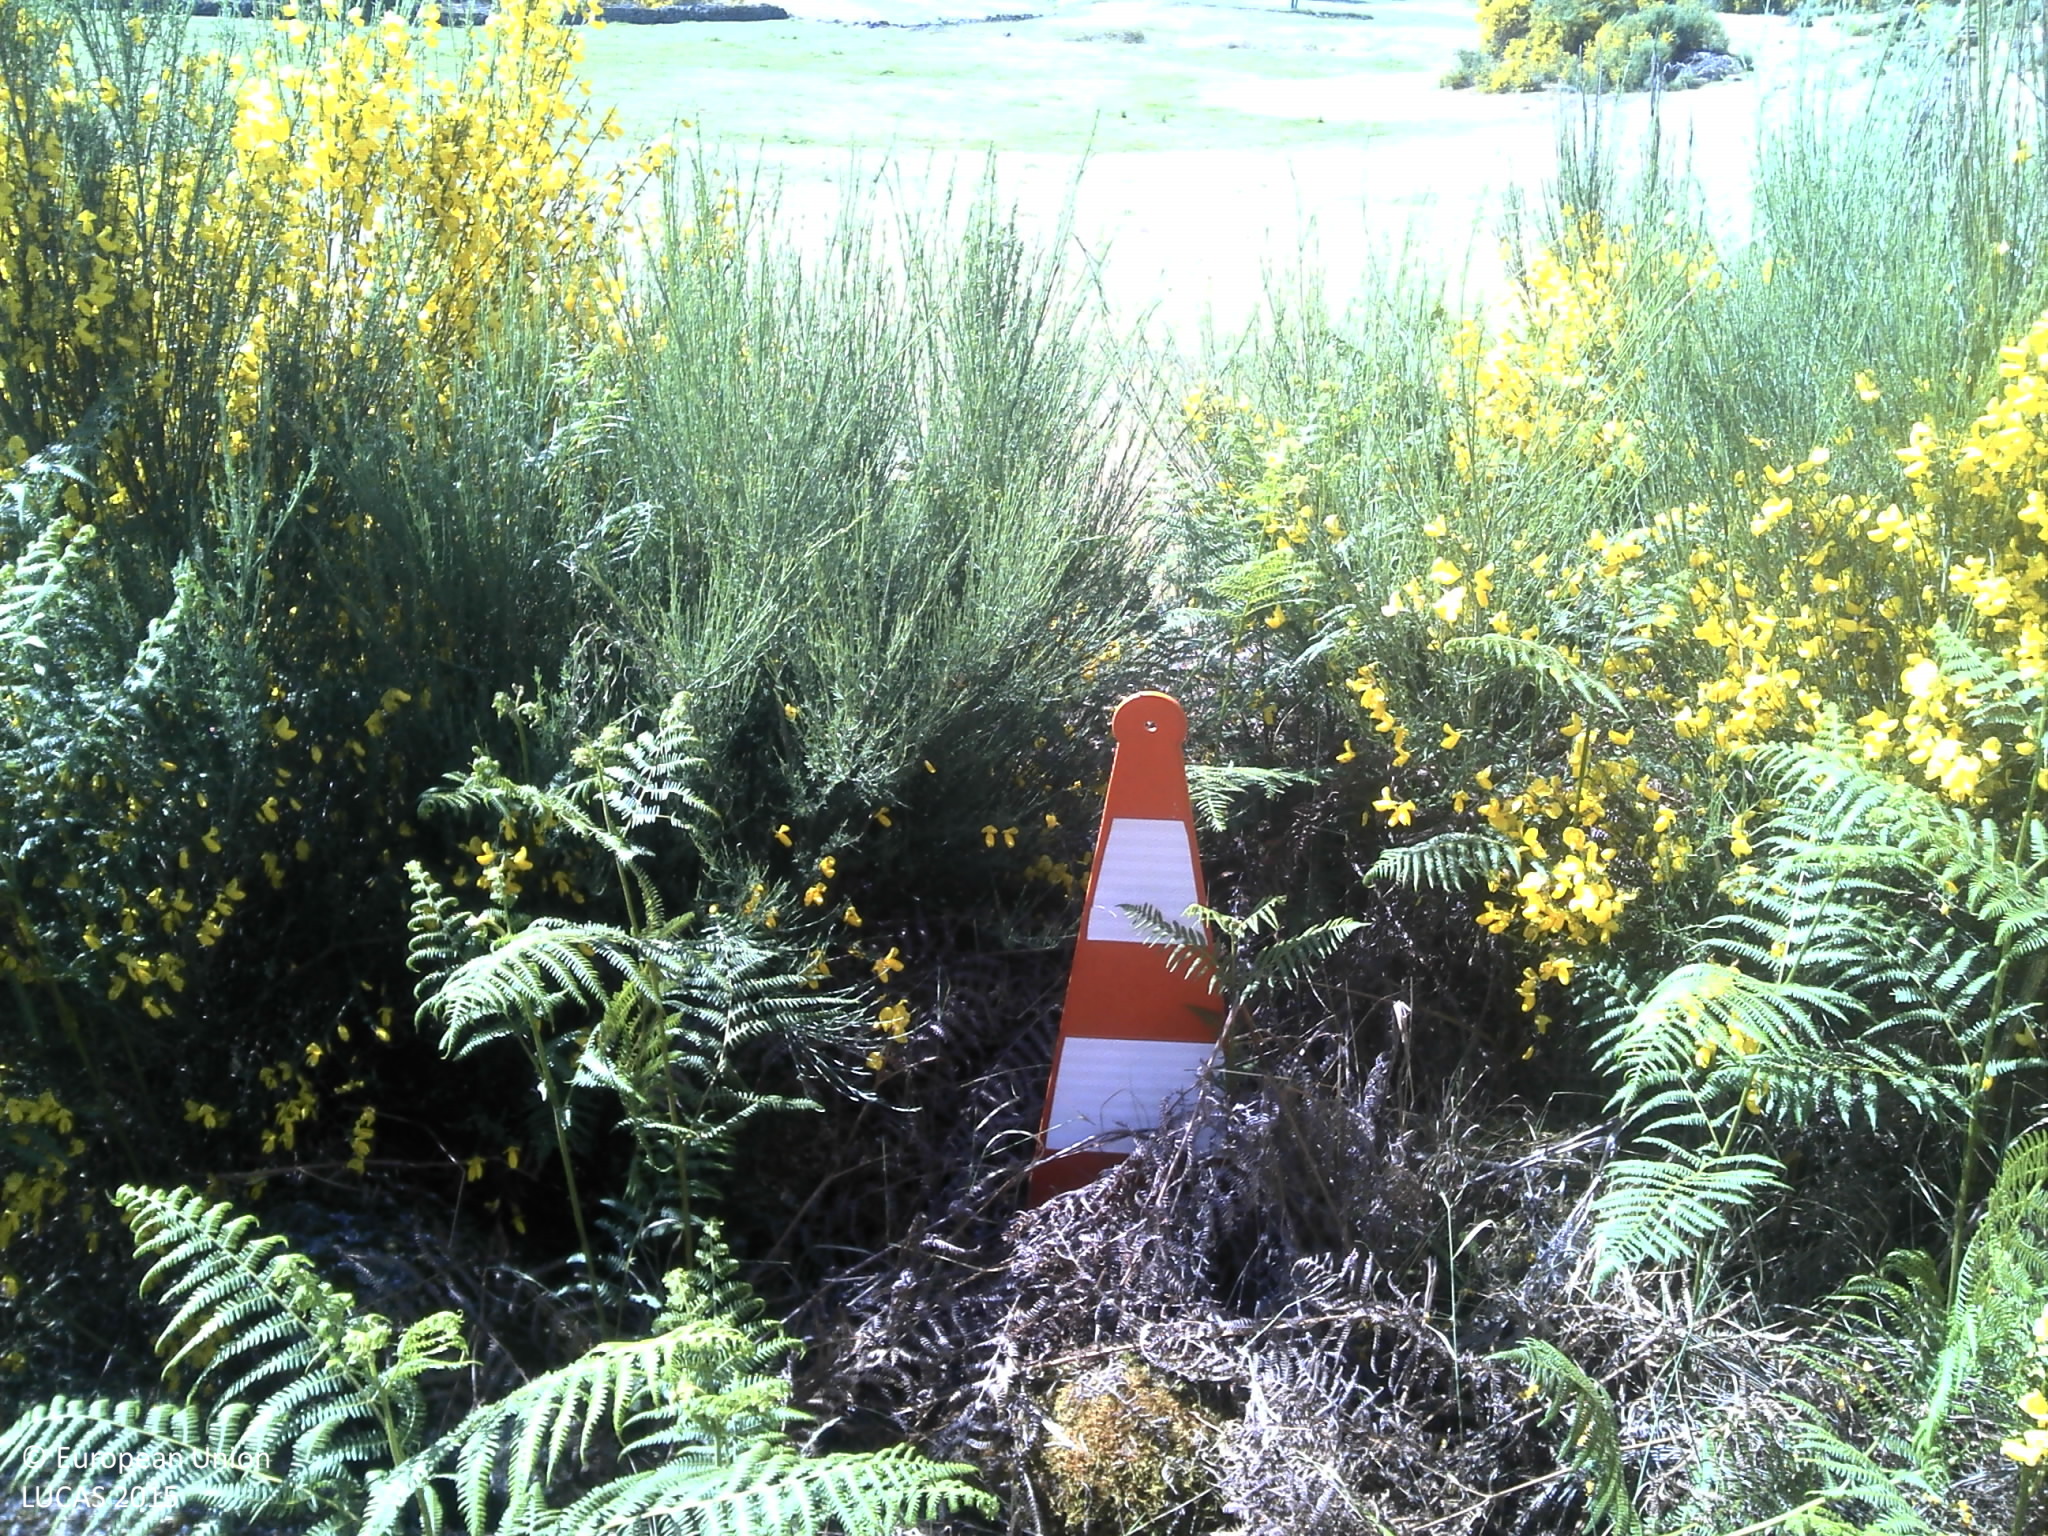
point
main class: Shrubland
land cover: Shrubland without tree cover
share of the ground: 25 - 50 %
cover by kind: shrubs 75 %, unconsolidated bare surface 20 %, herbaceous plants 5 %
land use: Agriculture (excluding fallow land and kitchen gardens)
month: May
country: PT
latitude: 40.5067
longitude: -7.3001
